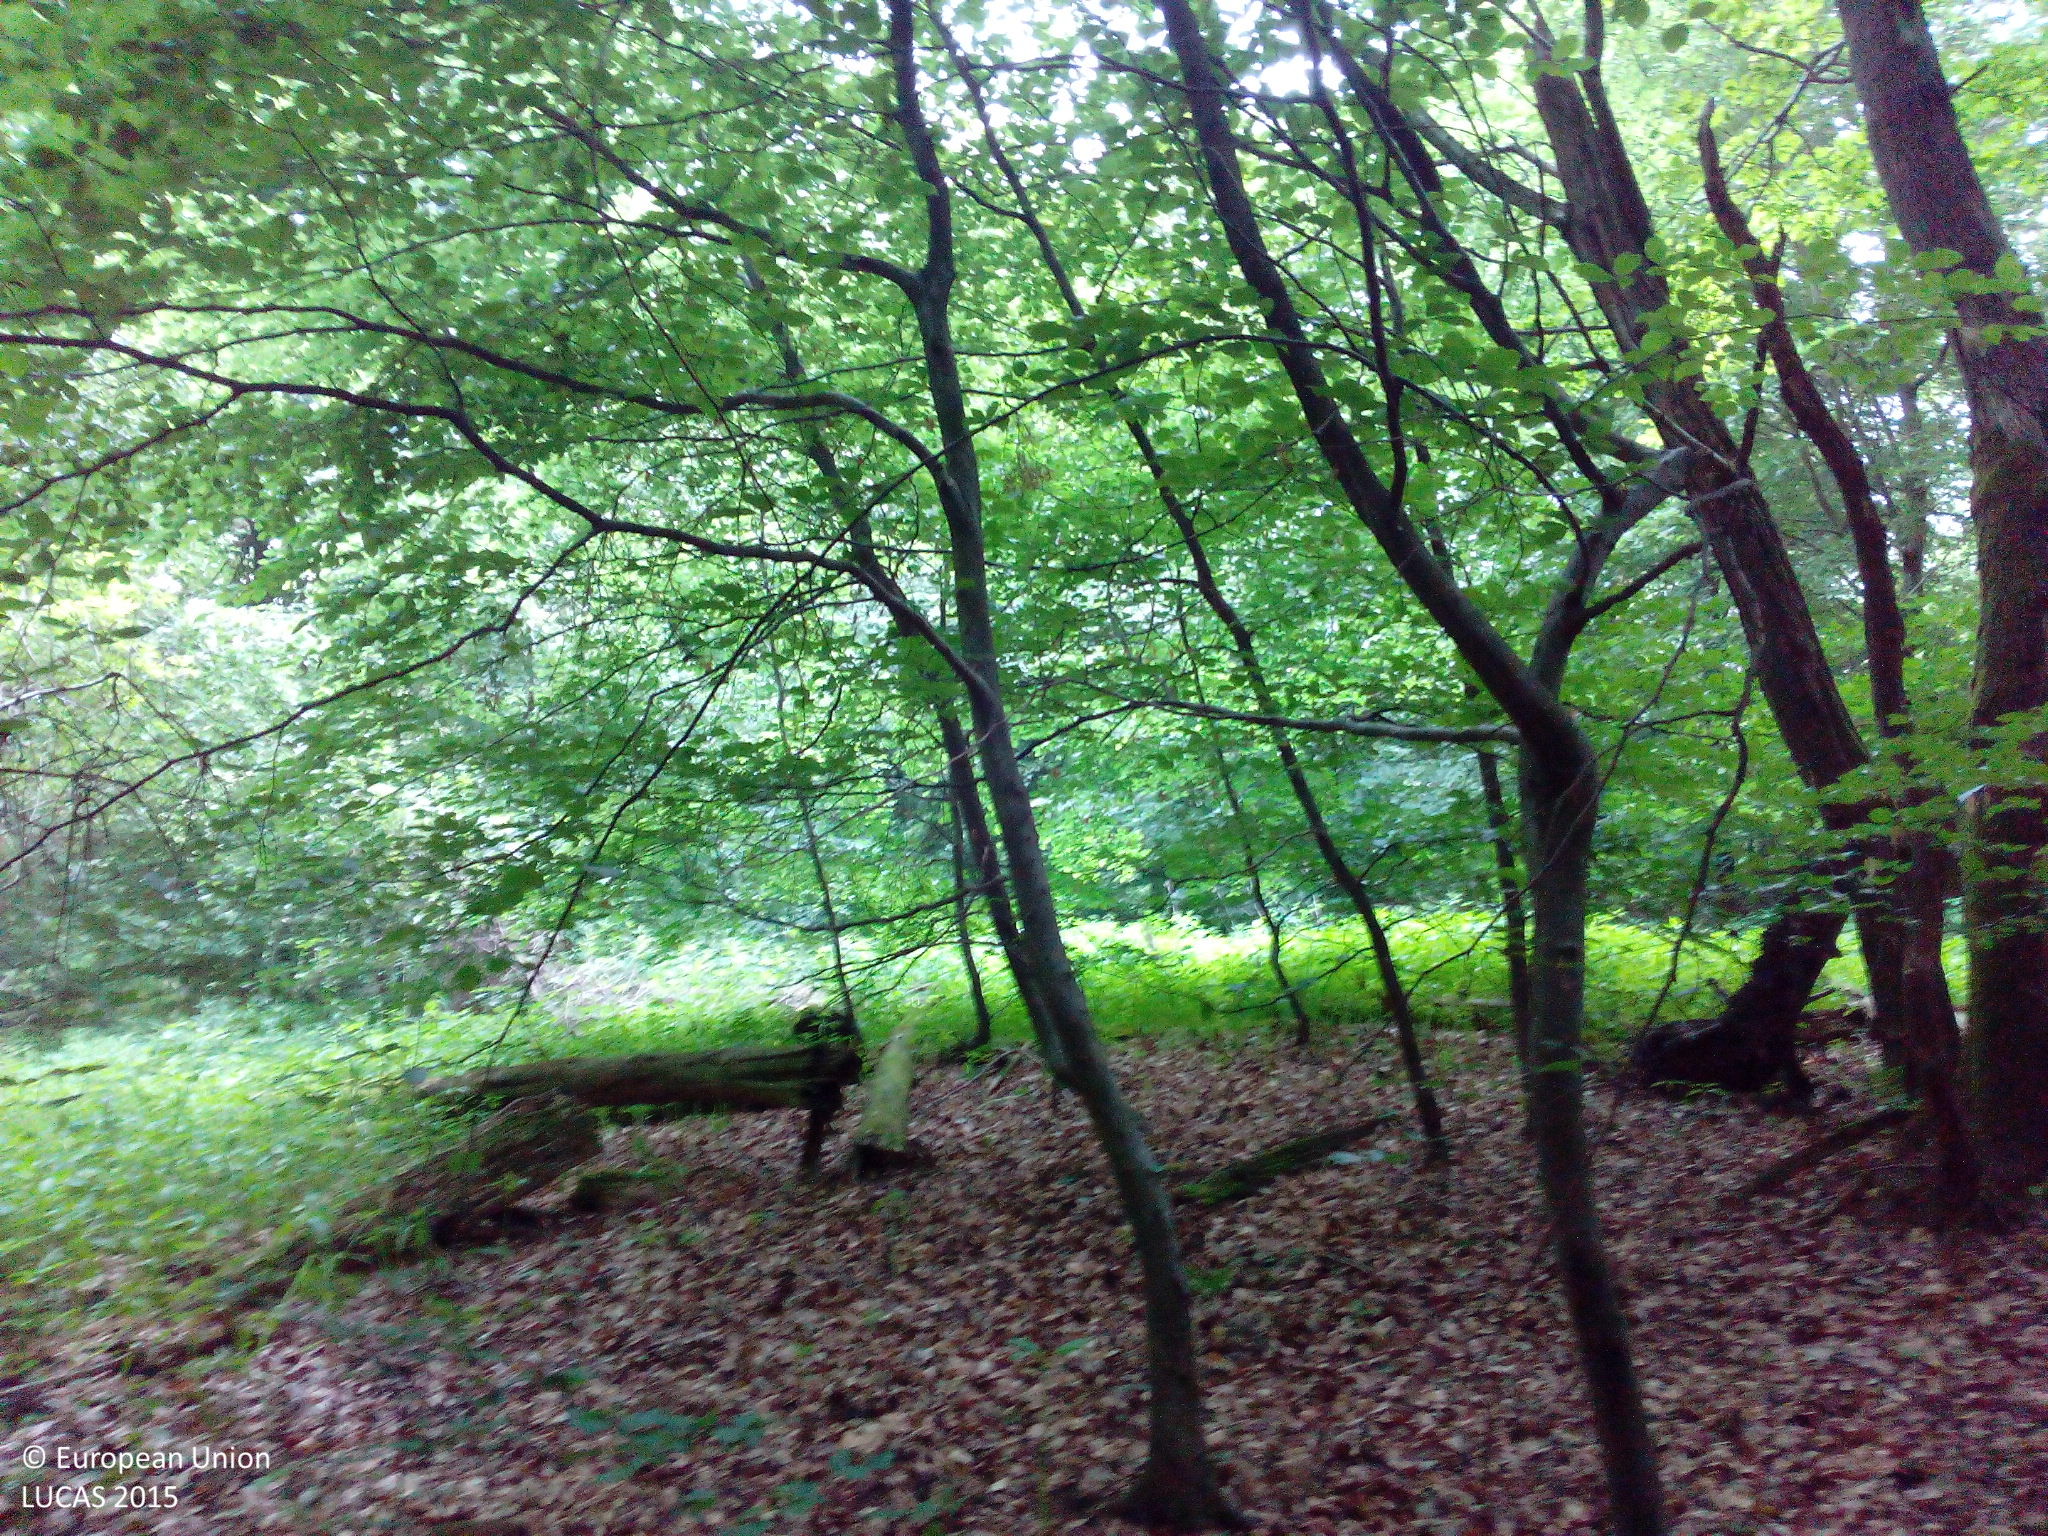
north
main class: Woodland
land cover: Broadleaved woodland
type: beech forest
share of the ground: > 75 %
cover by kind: broadleaved forest trees 85 %, coniferous forest trees 5 %, herbaceous plants 5 %, unconsolidated bare surface 5 %
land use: Forestry
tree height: > 5 m
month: May
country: DE
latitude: 48.7837
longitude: 8.1361
